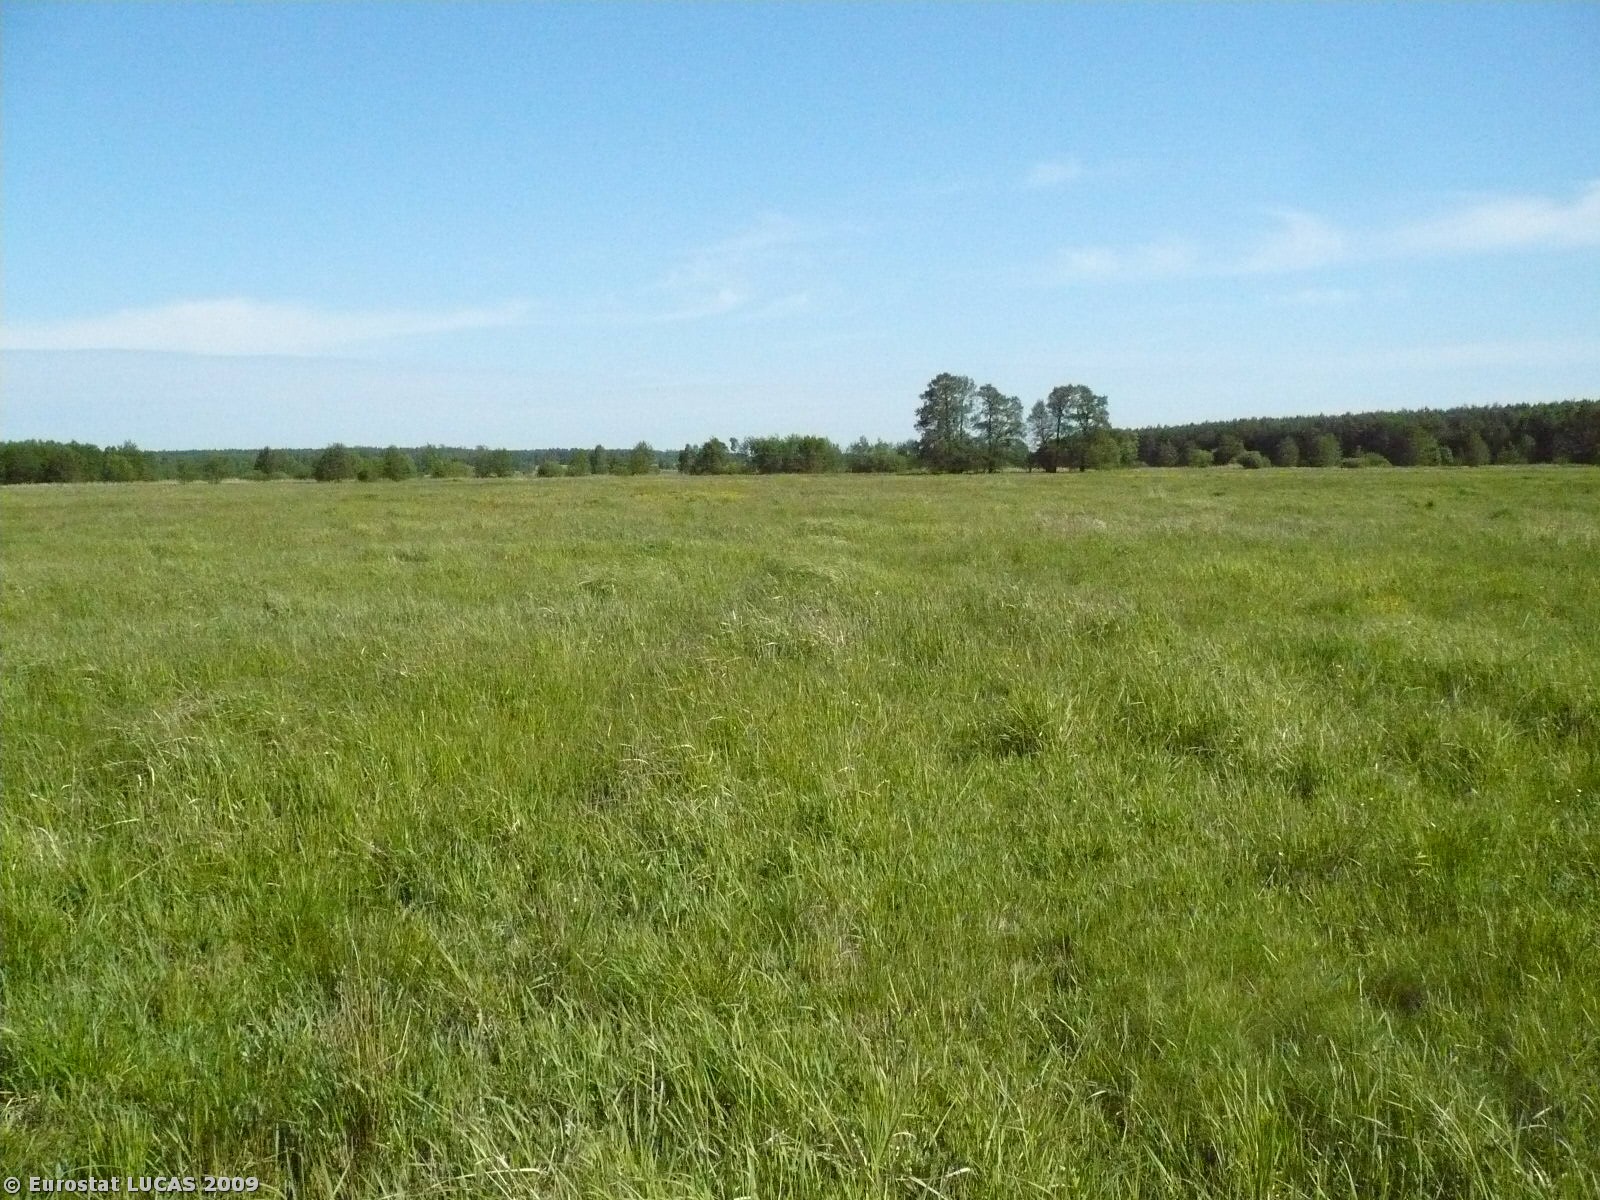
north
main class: Grassland
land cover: Grassland without tree/shrub cover
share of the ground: > 75 %
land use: Agriculture (excluding fallow land and kitchen gardens)
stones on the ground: < 10 %
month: May
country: PL
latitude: 51.8465
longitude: 15.6514
